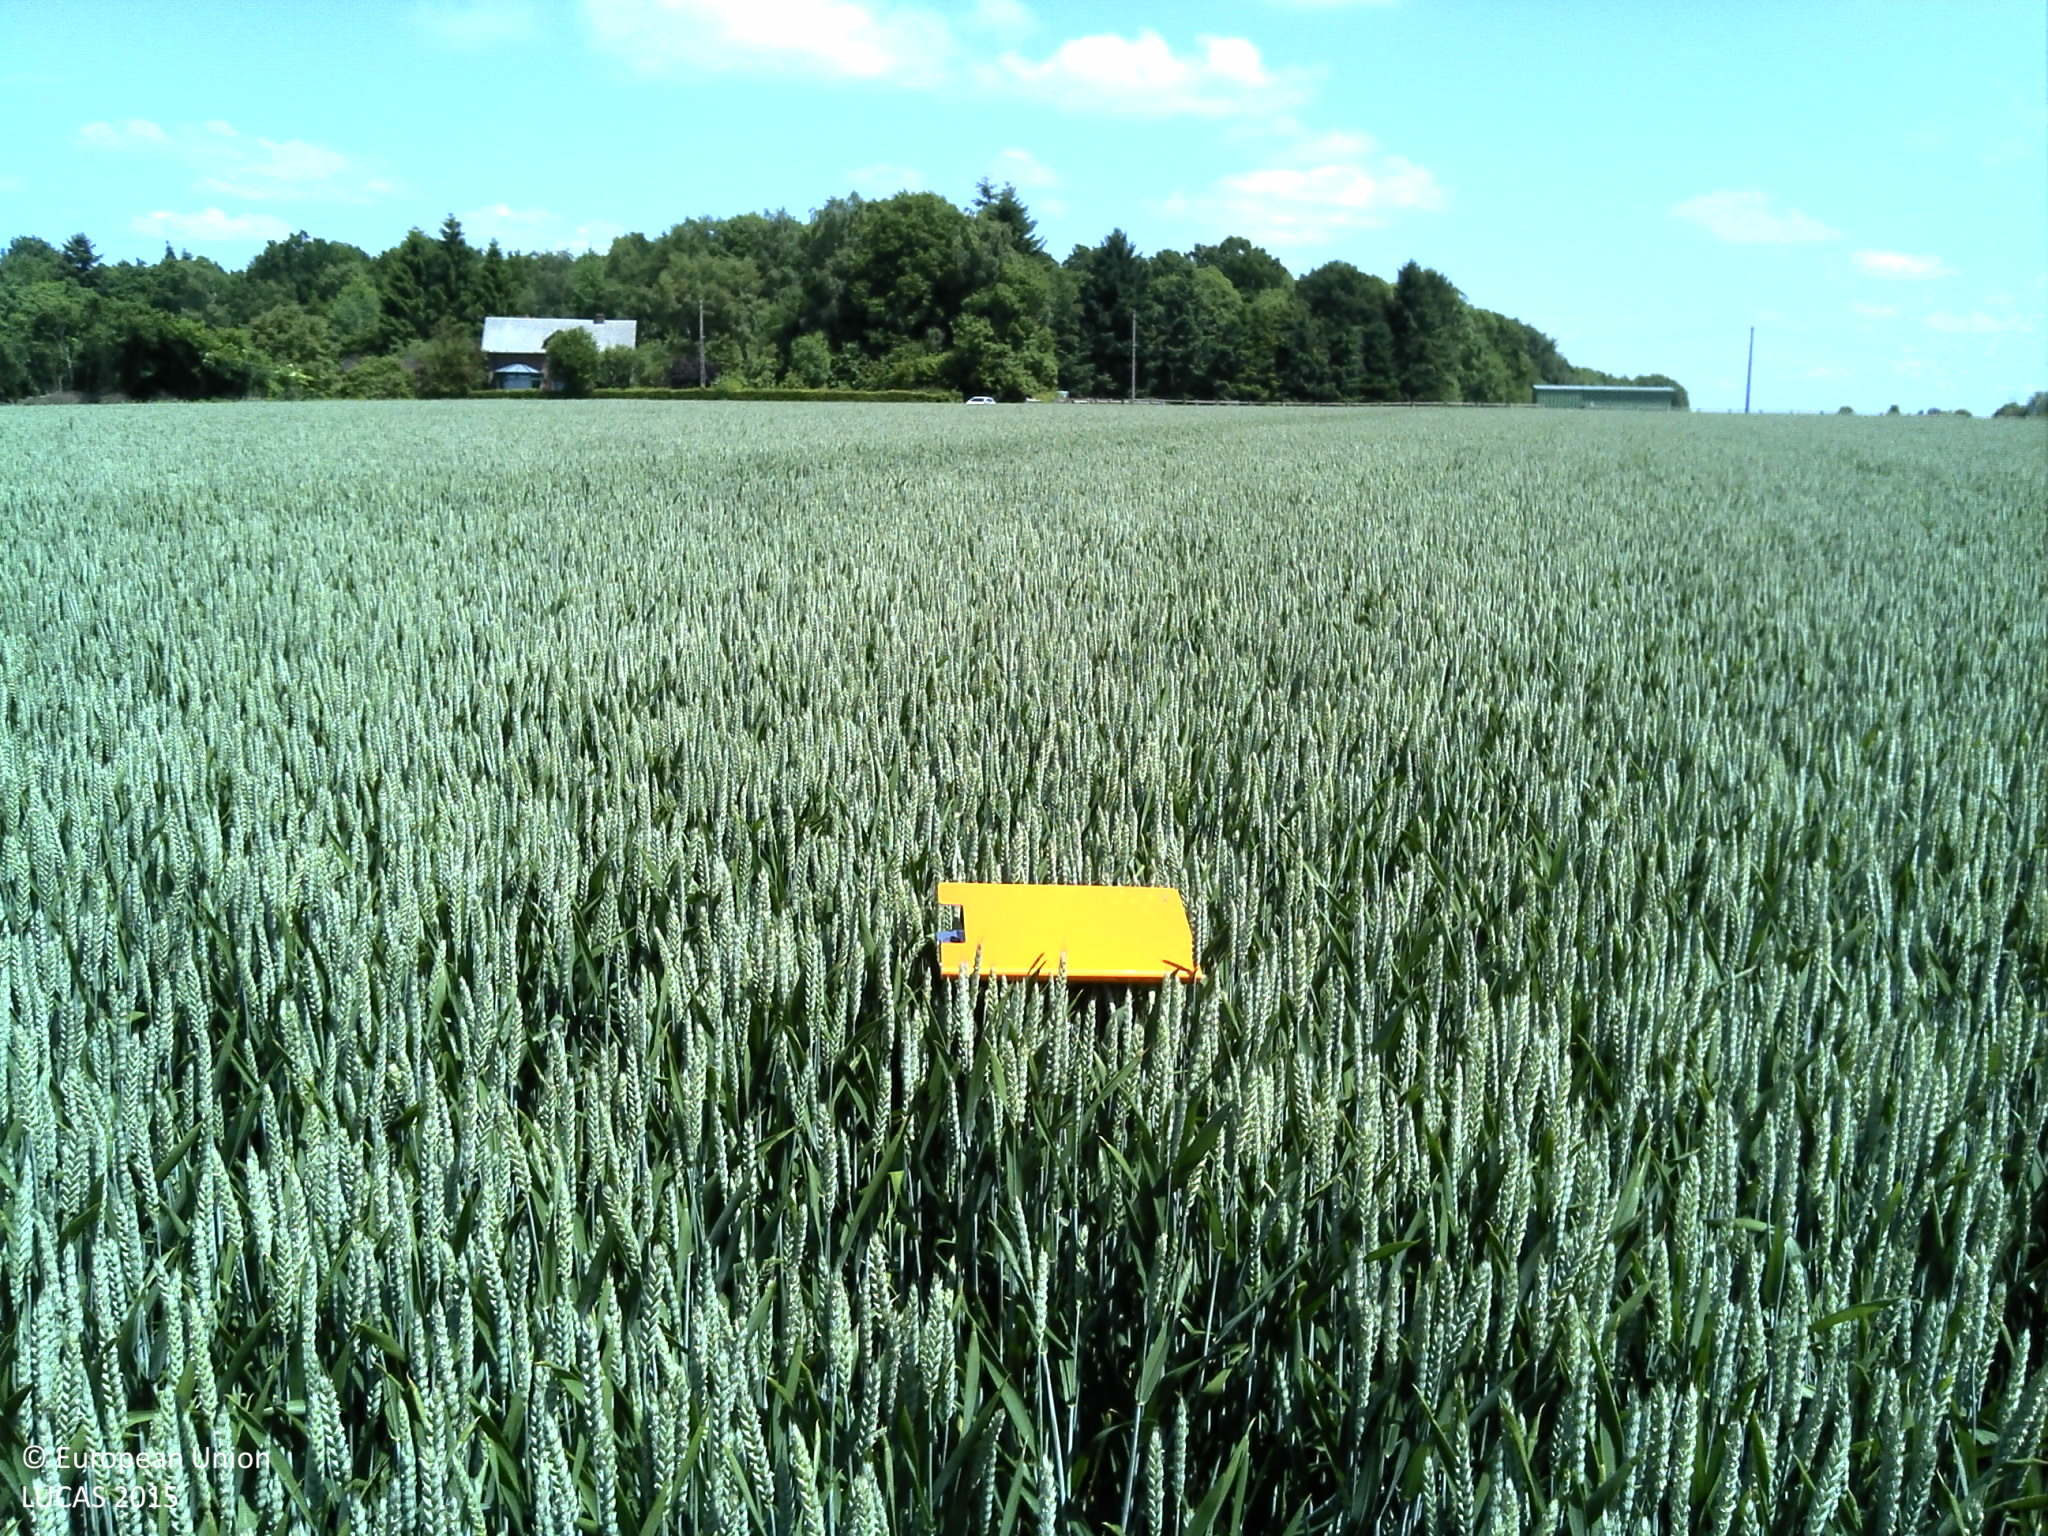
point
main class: Cropland
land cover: Common wheat
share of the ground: > 75 %
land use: Agriculture (excluding fallow land and kitchen gardens)
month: June
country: FR
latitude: 49.5141
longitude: 1.1531
